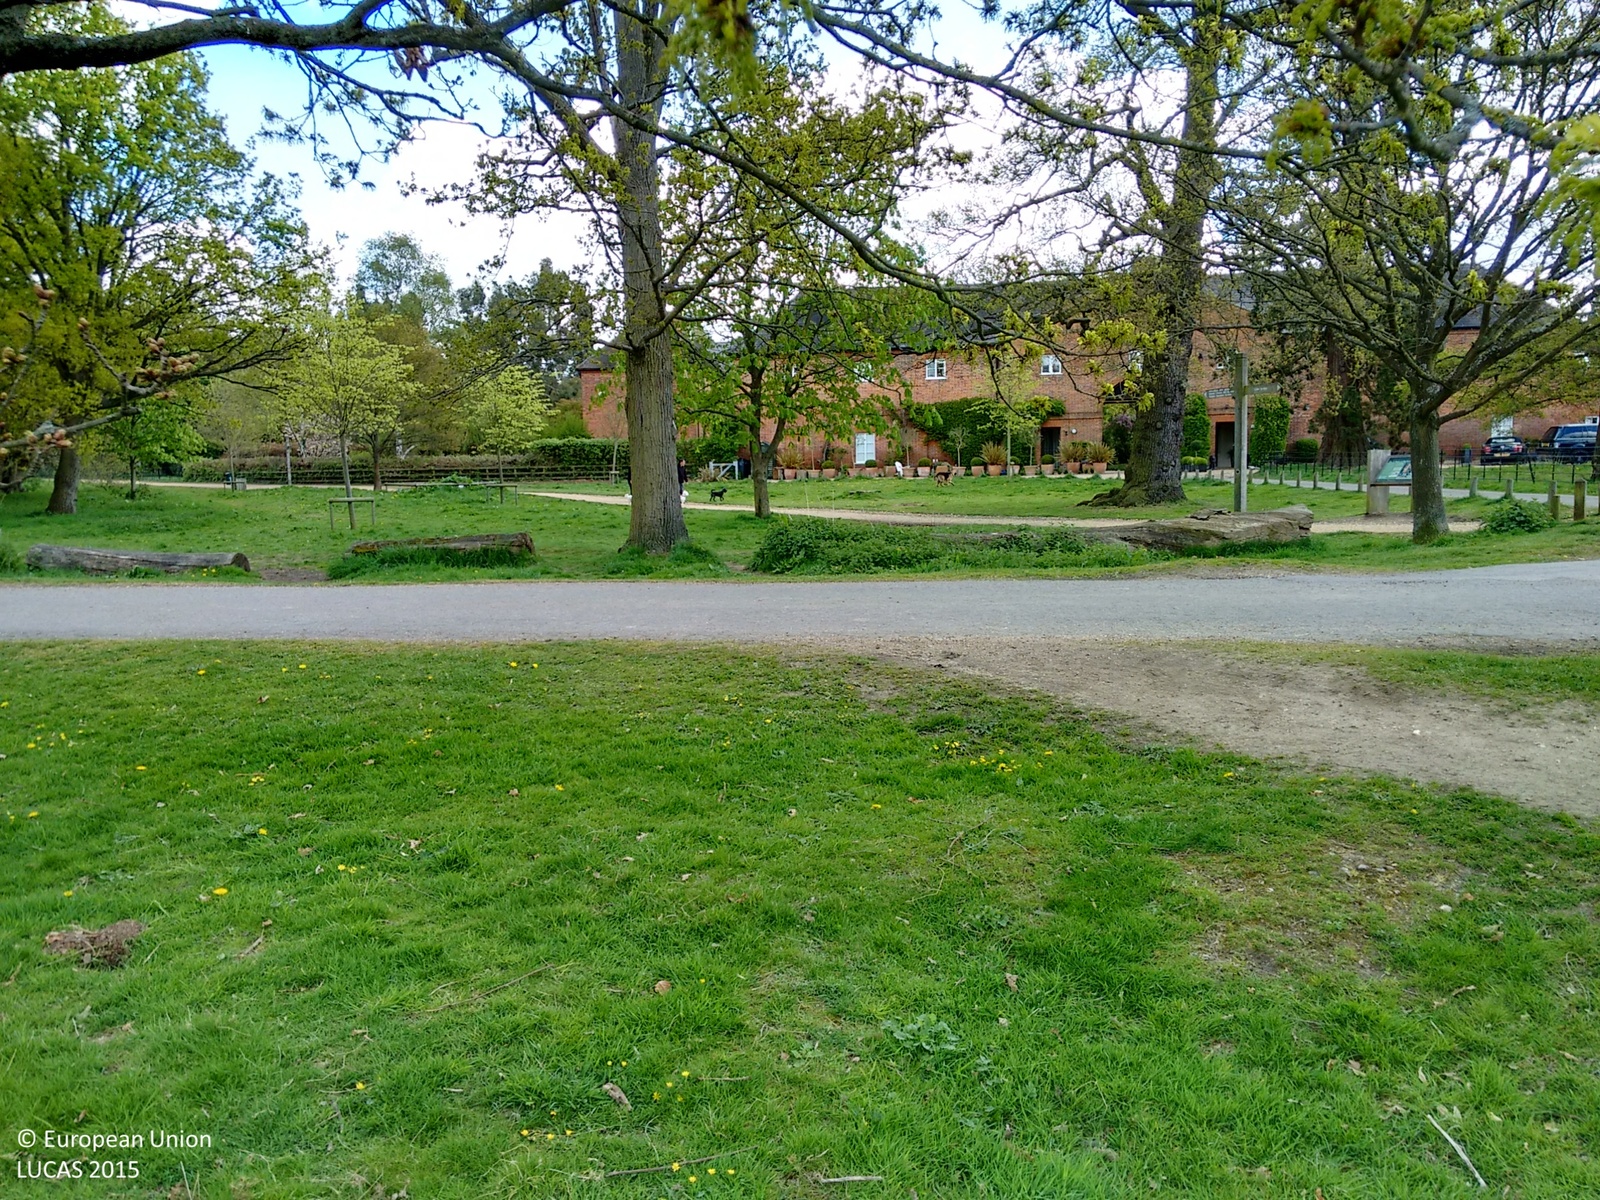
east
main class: Woodland
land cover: Broadleaved woodland
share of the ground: 50 - 75 %
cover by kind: broadleaved forest trees 50 %, herbaceous plants 50 %
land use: Residential
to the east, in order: Broadleaved woodland; Paved roads, cycling and walking lanes; Broadleaved woodland; Tracks; Grassland with sparse tree/shrub cover; Artificial constructions in urban areas
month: April
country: GB
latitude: 51.5255
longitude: -0.5464
